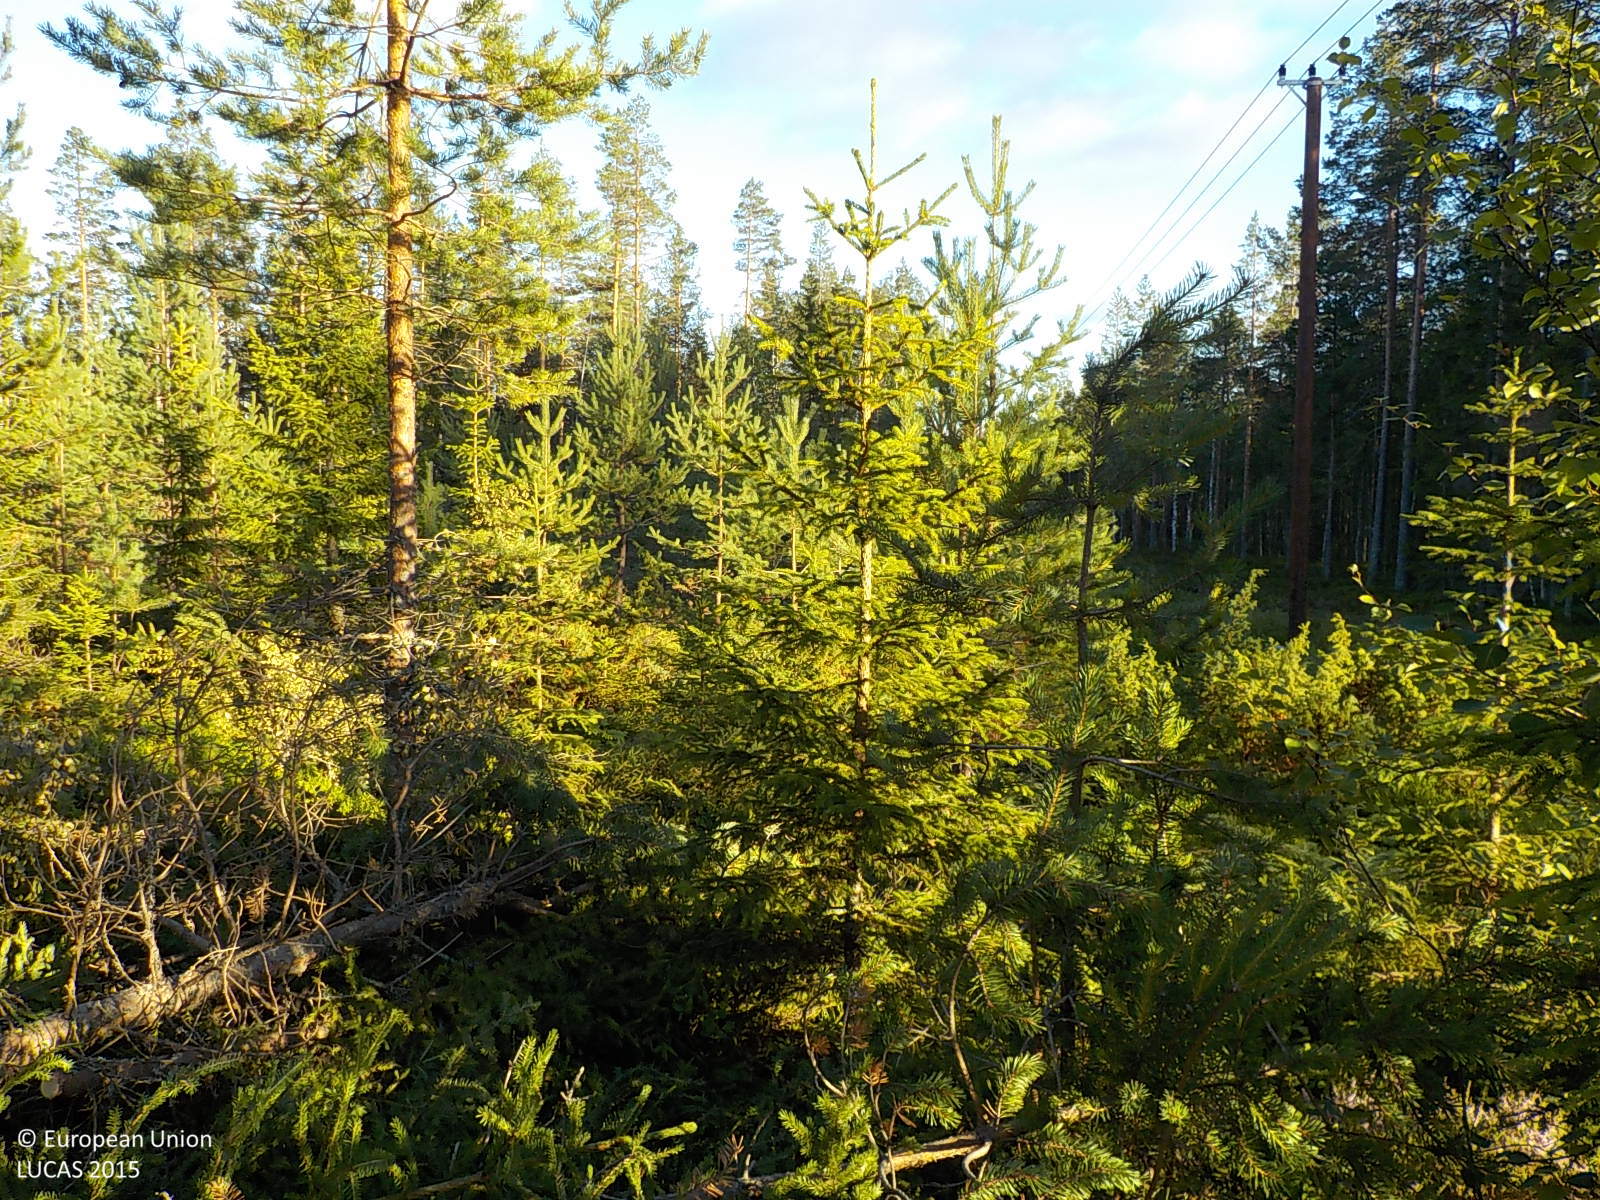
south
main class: Woodland
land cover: Other coniferous woodland
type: boreal forest
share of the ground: > 75 %
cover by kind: coniferous forest trees 80 %, shrubs 15 %, broadleaved forest trees 5 %
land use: Forestry
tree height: > 5 m
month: August
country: SE
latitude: 63.4078
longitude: 18.8080
